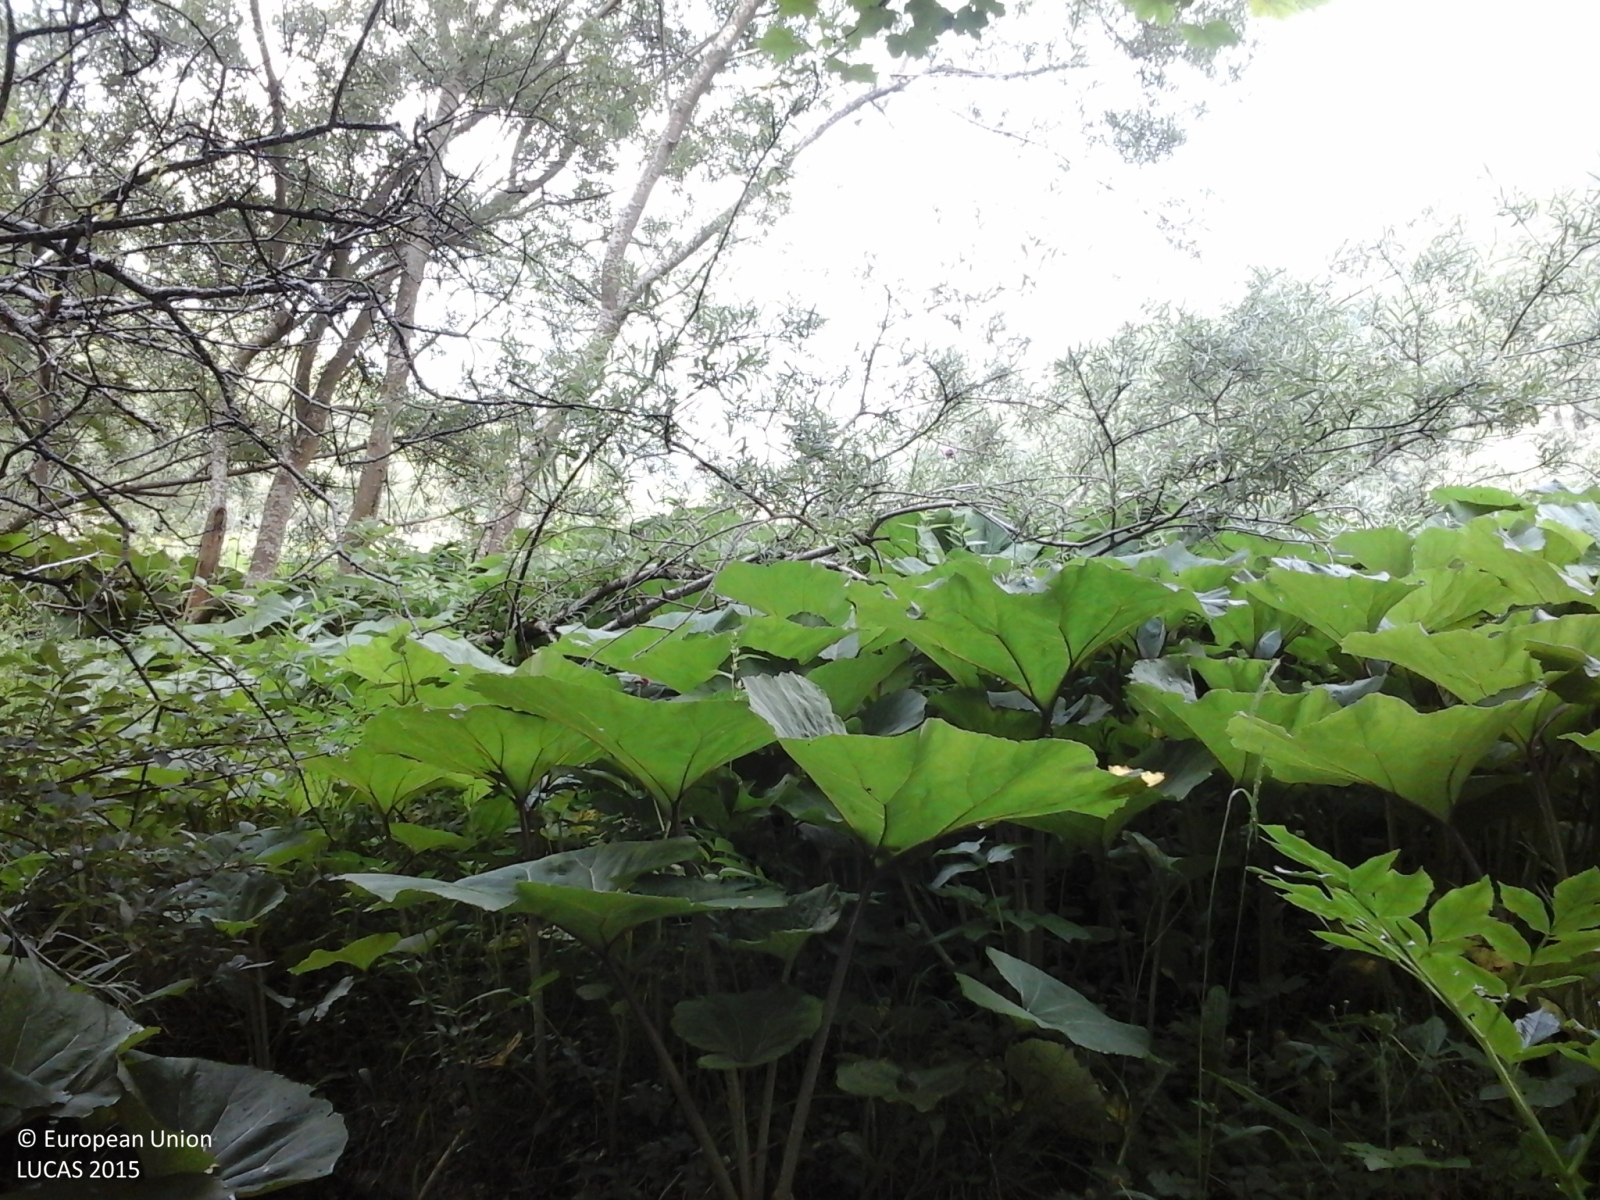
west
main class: Woodland
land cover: Broadleaved woodland
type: mesophytic deciduous forest
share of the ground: > 75 %
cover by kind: broadleaved forest trees 90 %, herbaceous plants 10 %
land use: Forestry
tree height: > 5 m
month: July
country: IT
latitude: 45.3060
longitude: 7.2367
